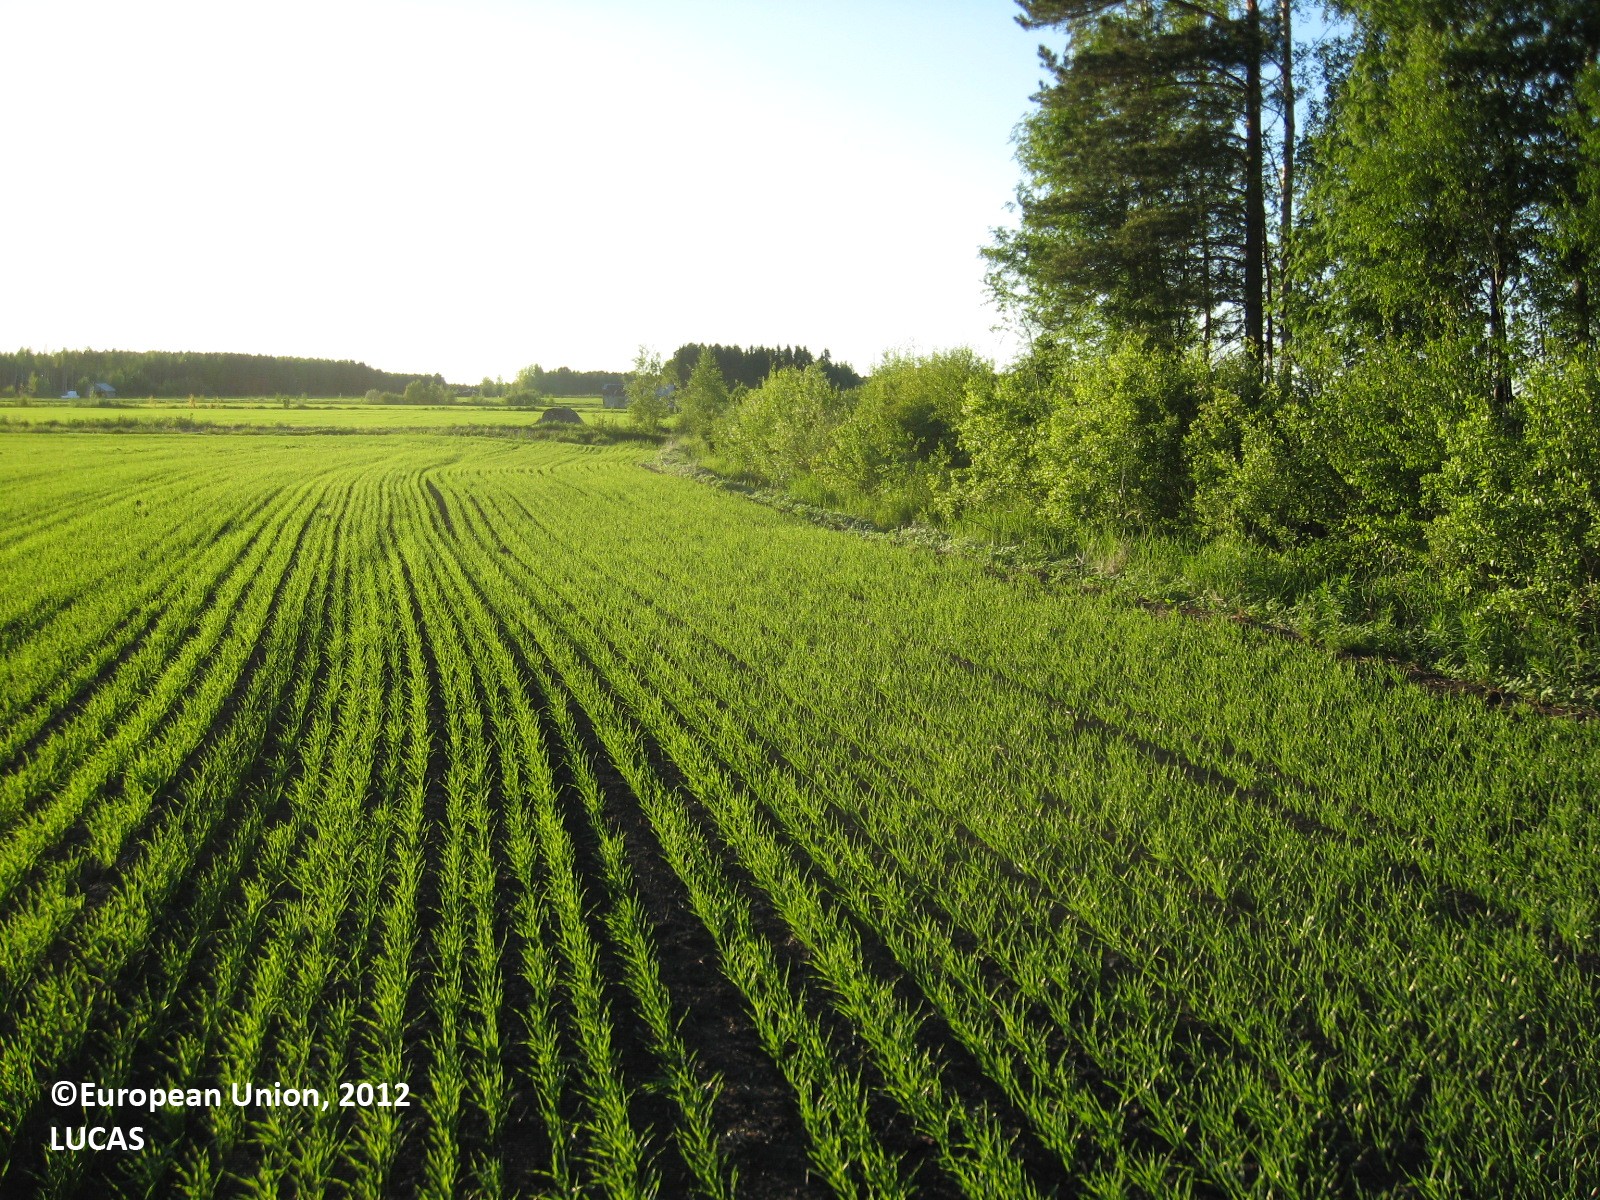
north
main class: Cropland
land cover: Barley
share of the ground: 50 - 75 %
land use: Agriculture (excluding fallow land and kitchen gardens)
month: June
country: FI
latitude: 63.2379
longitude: 22.7731
